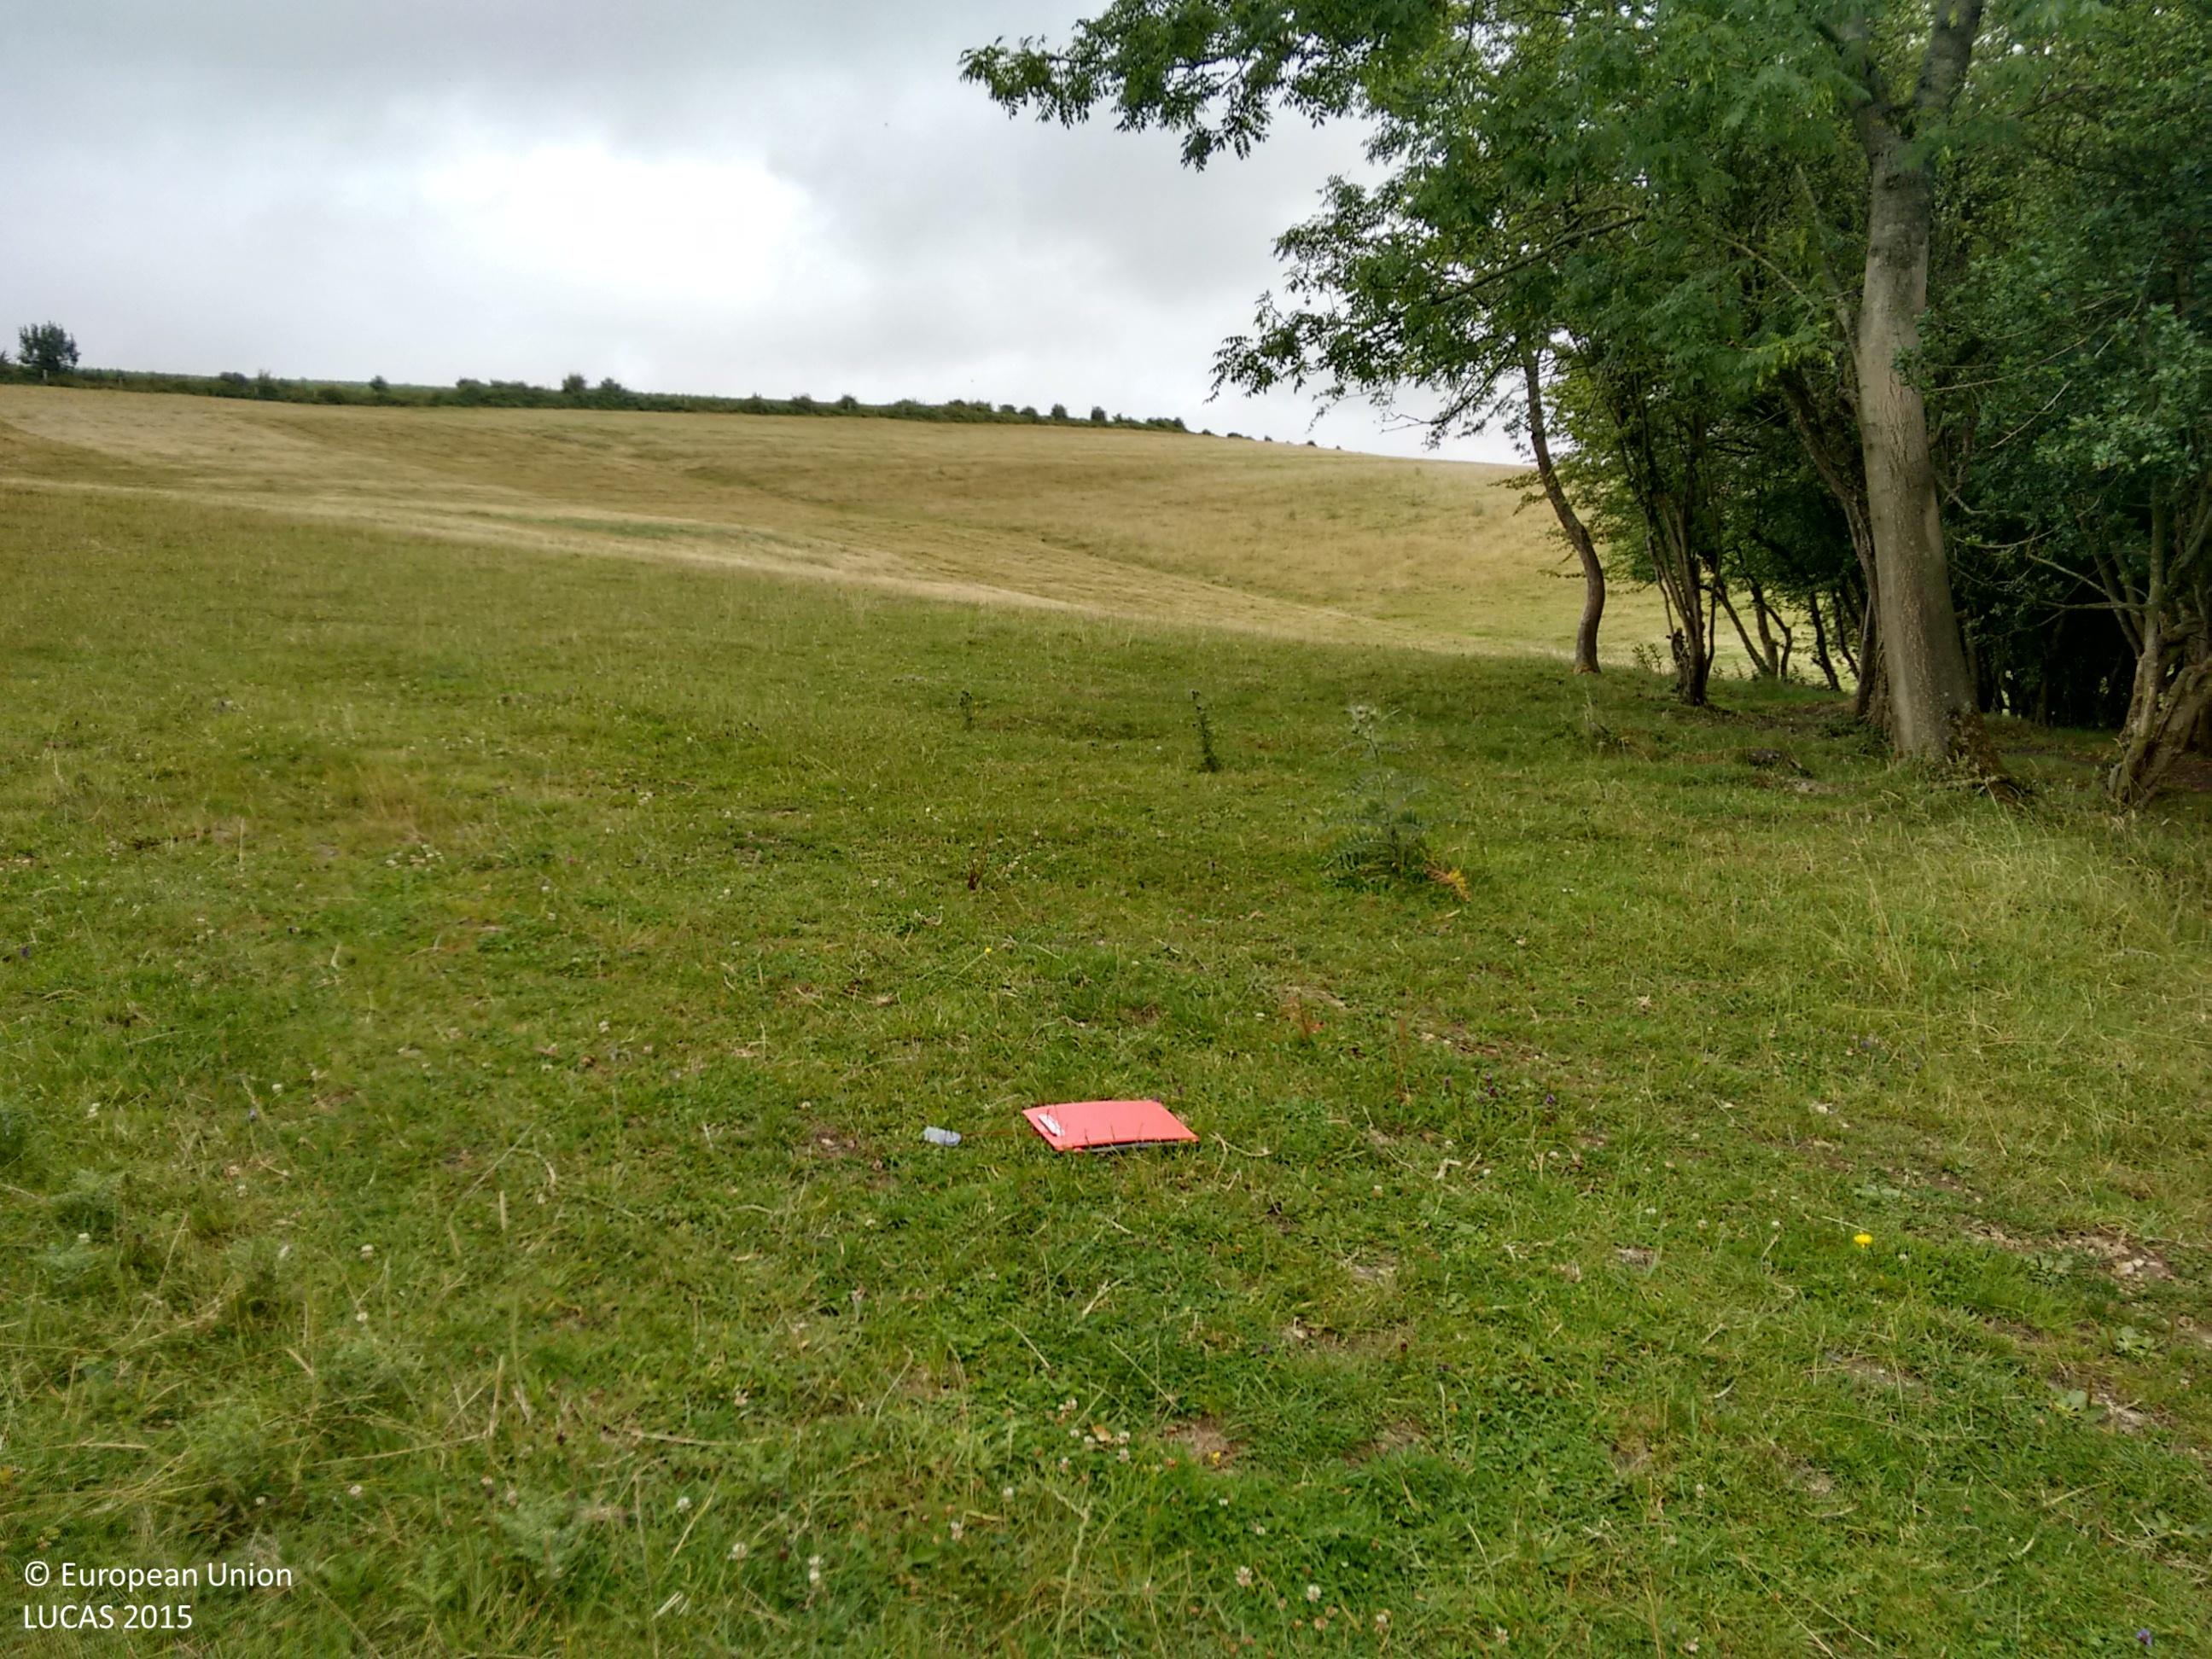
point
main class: Grassland
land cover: Grassland without tree/shrub cover
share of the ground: > 75 %
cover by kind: herbaceous plants 100 %
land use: Agriculture (excluding fallow land and kitchen gardens)
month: July
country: GB
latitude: 51.4576
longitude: -2.3403
